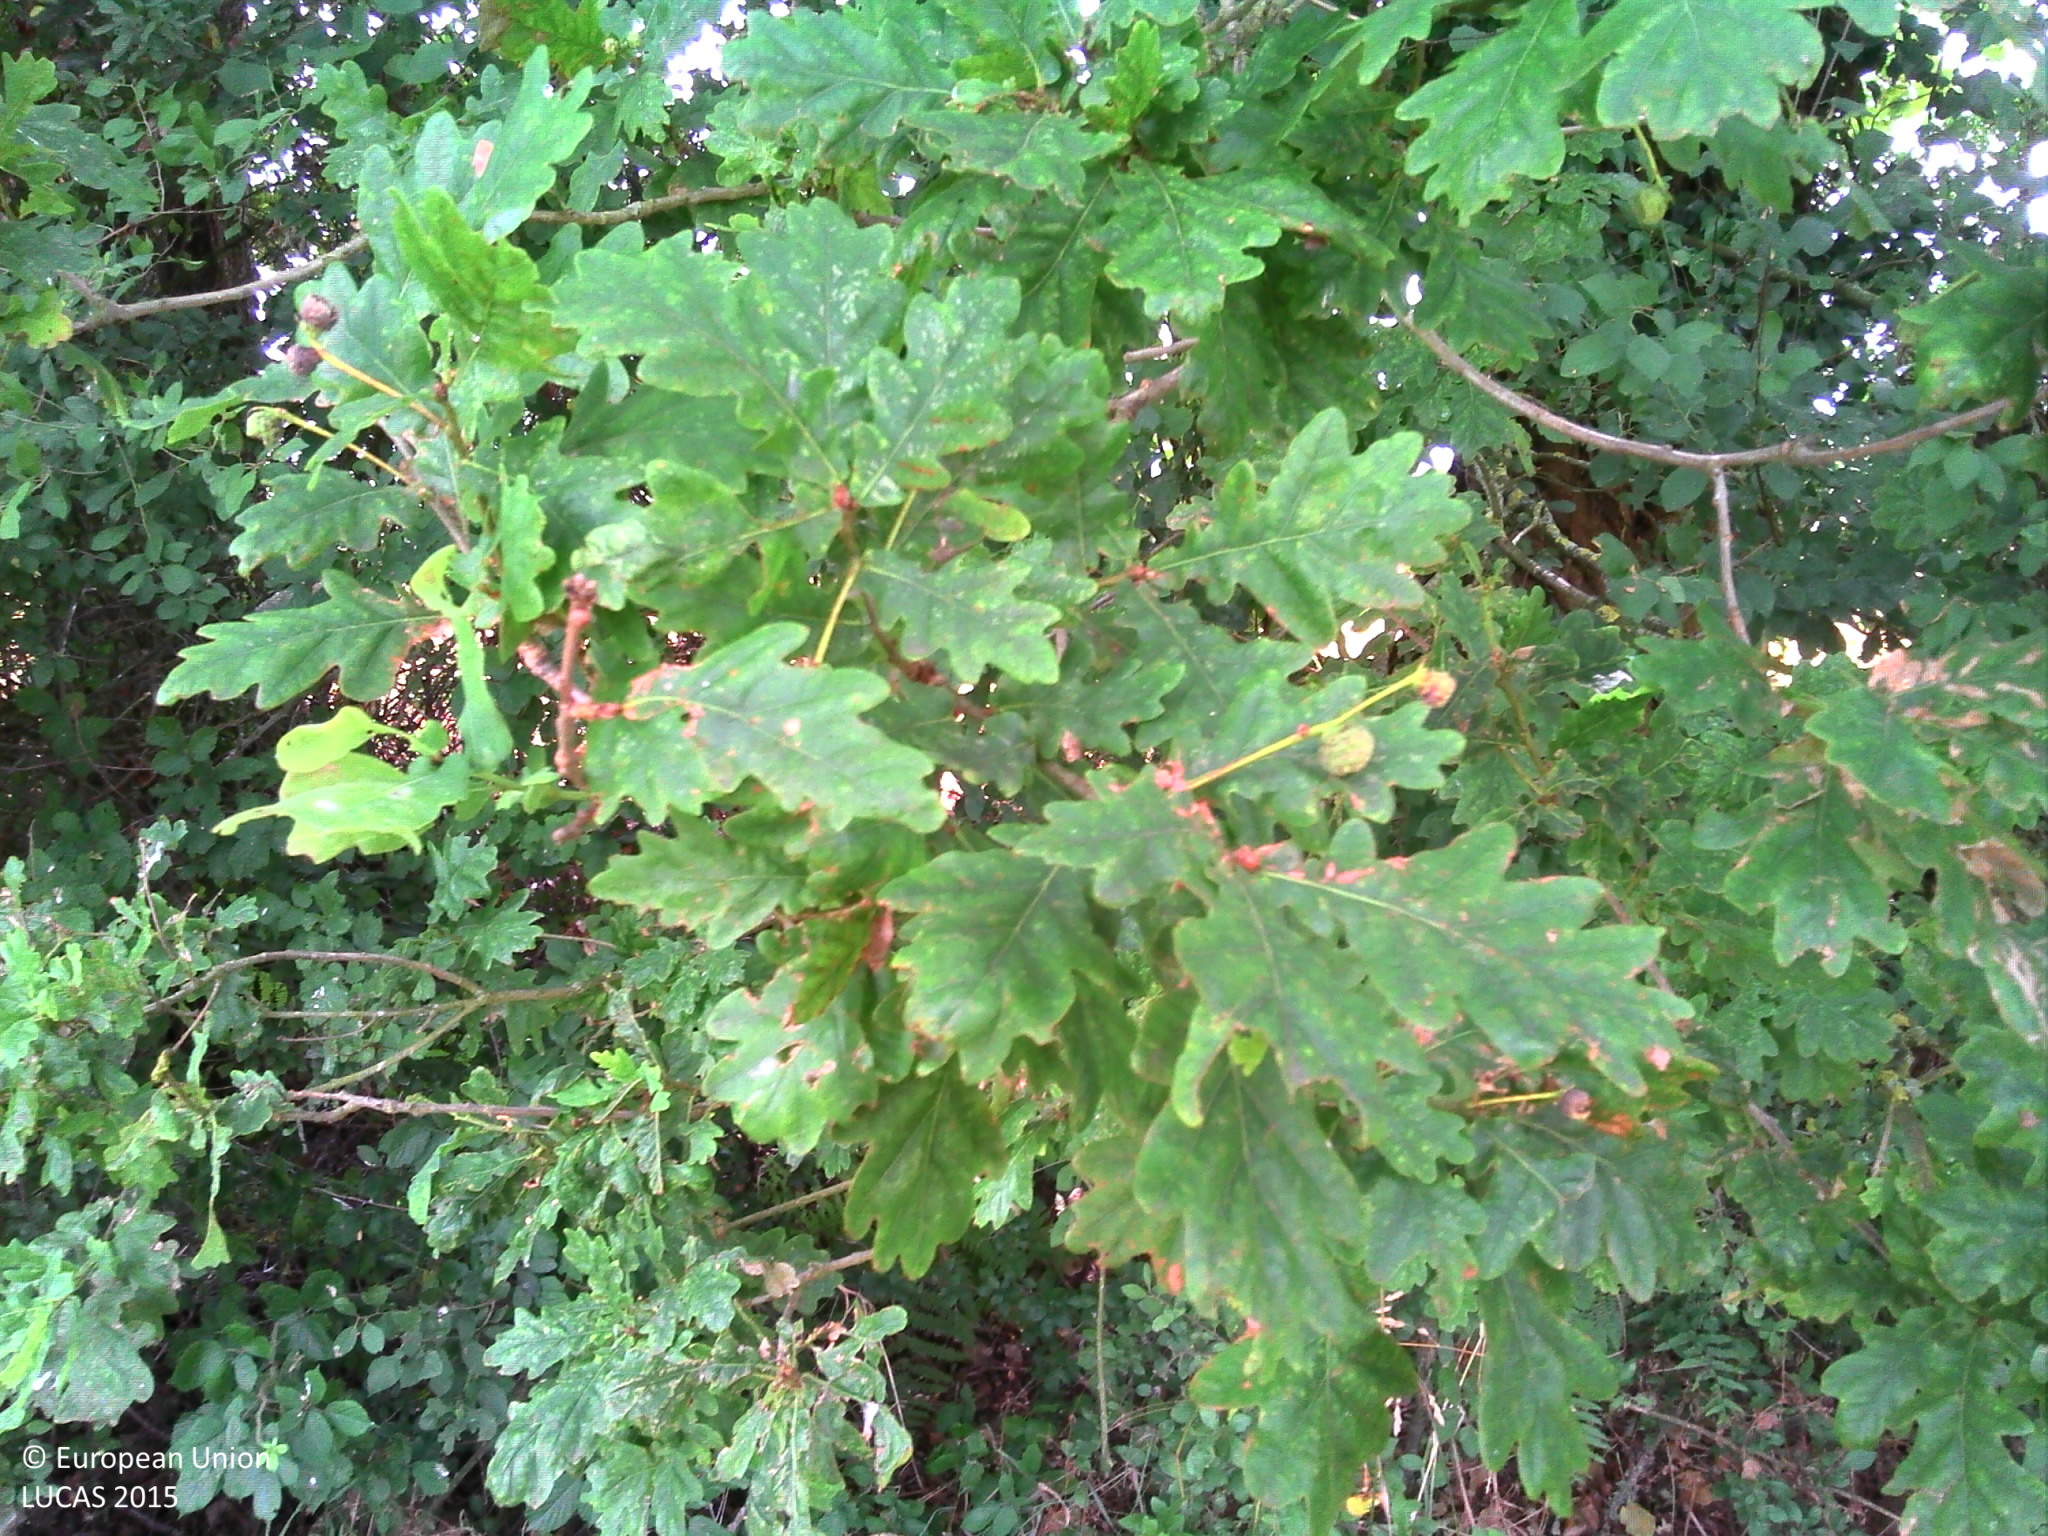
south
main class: Woodland
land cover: Broadleaved woodland
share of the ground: > 75 %
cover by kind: broadleaved forest trees 80 %, herbaceous plants 20 %
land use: Semi-natural and natural areas not in use
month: July
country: FR
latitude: 48.3963
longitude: -0.0650
